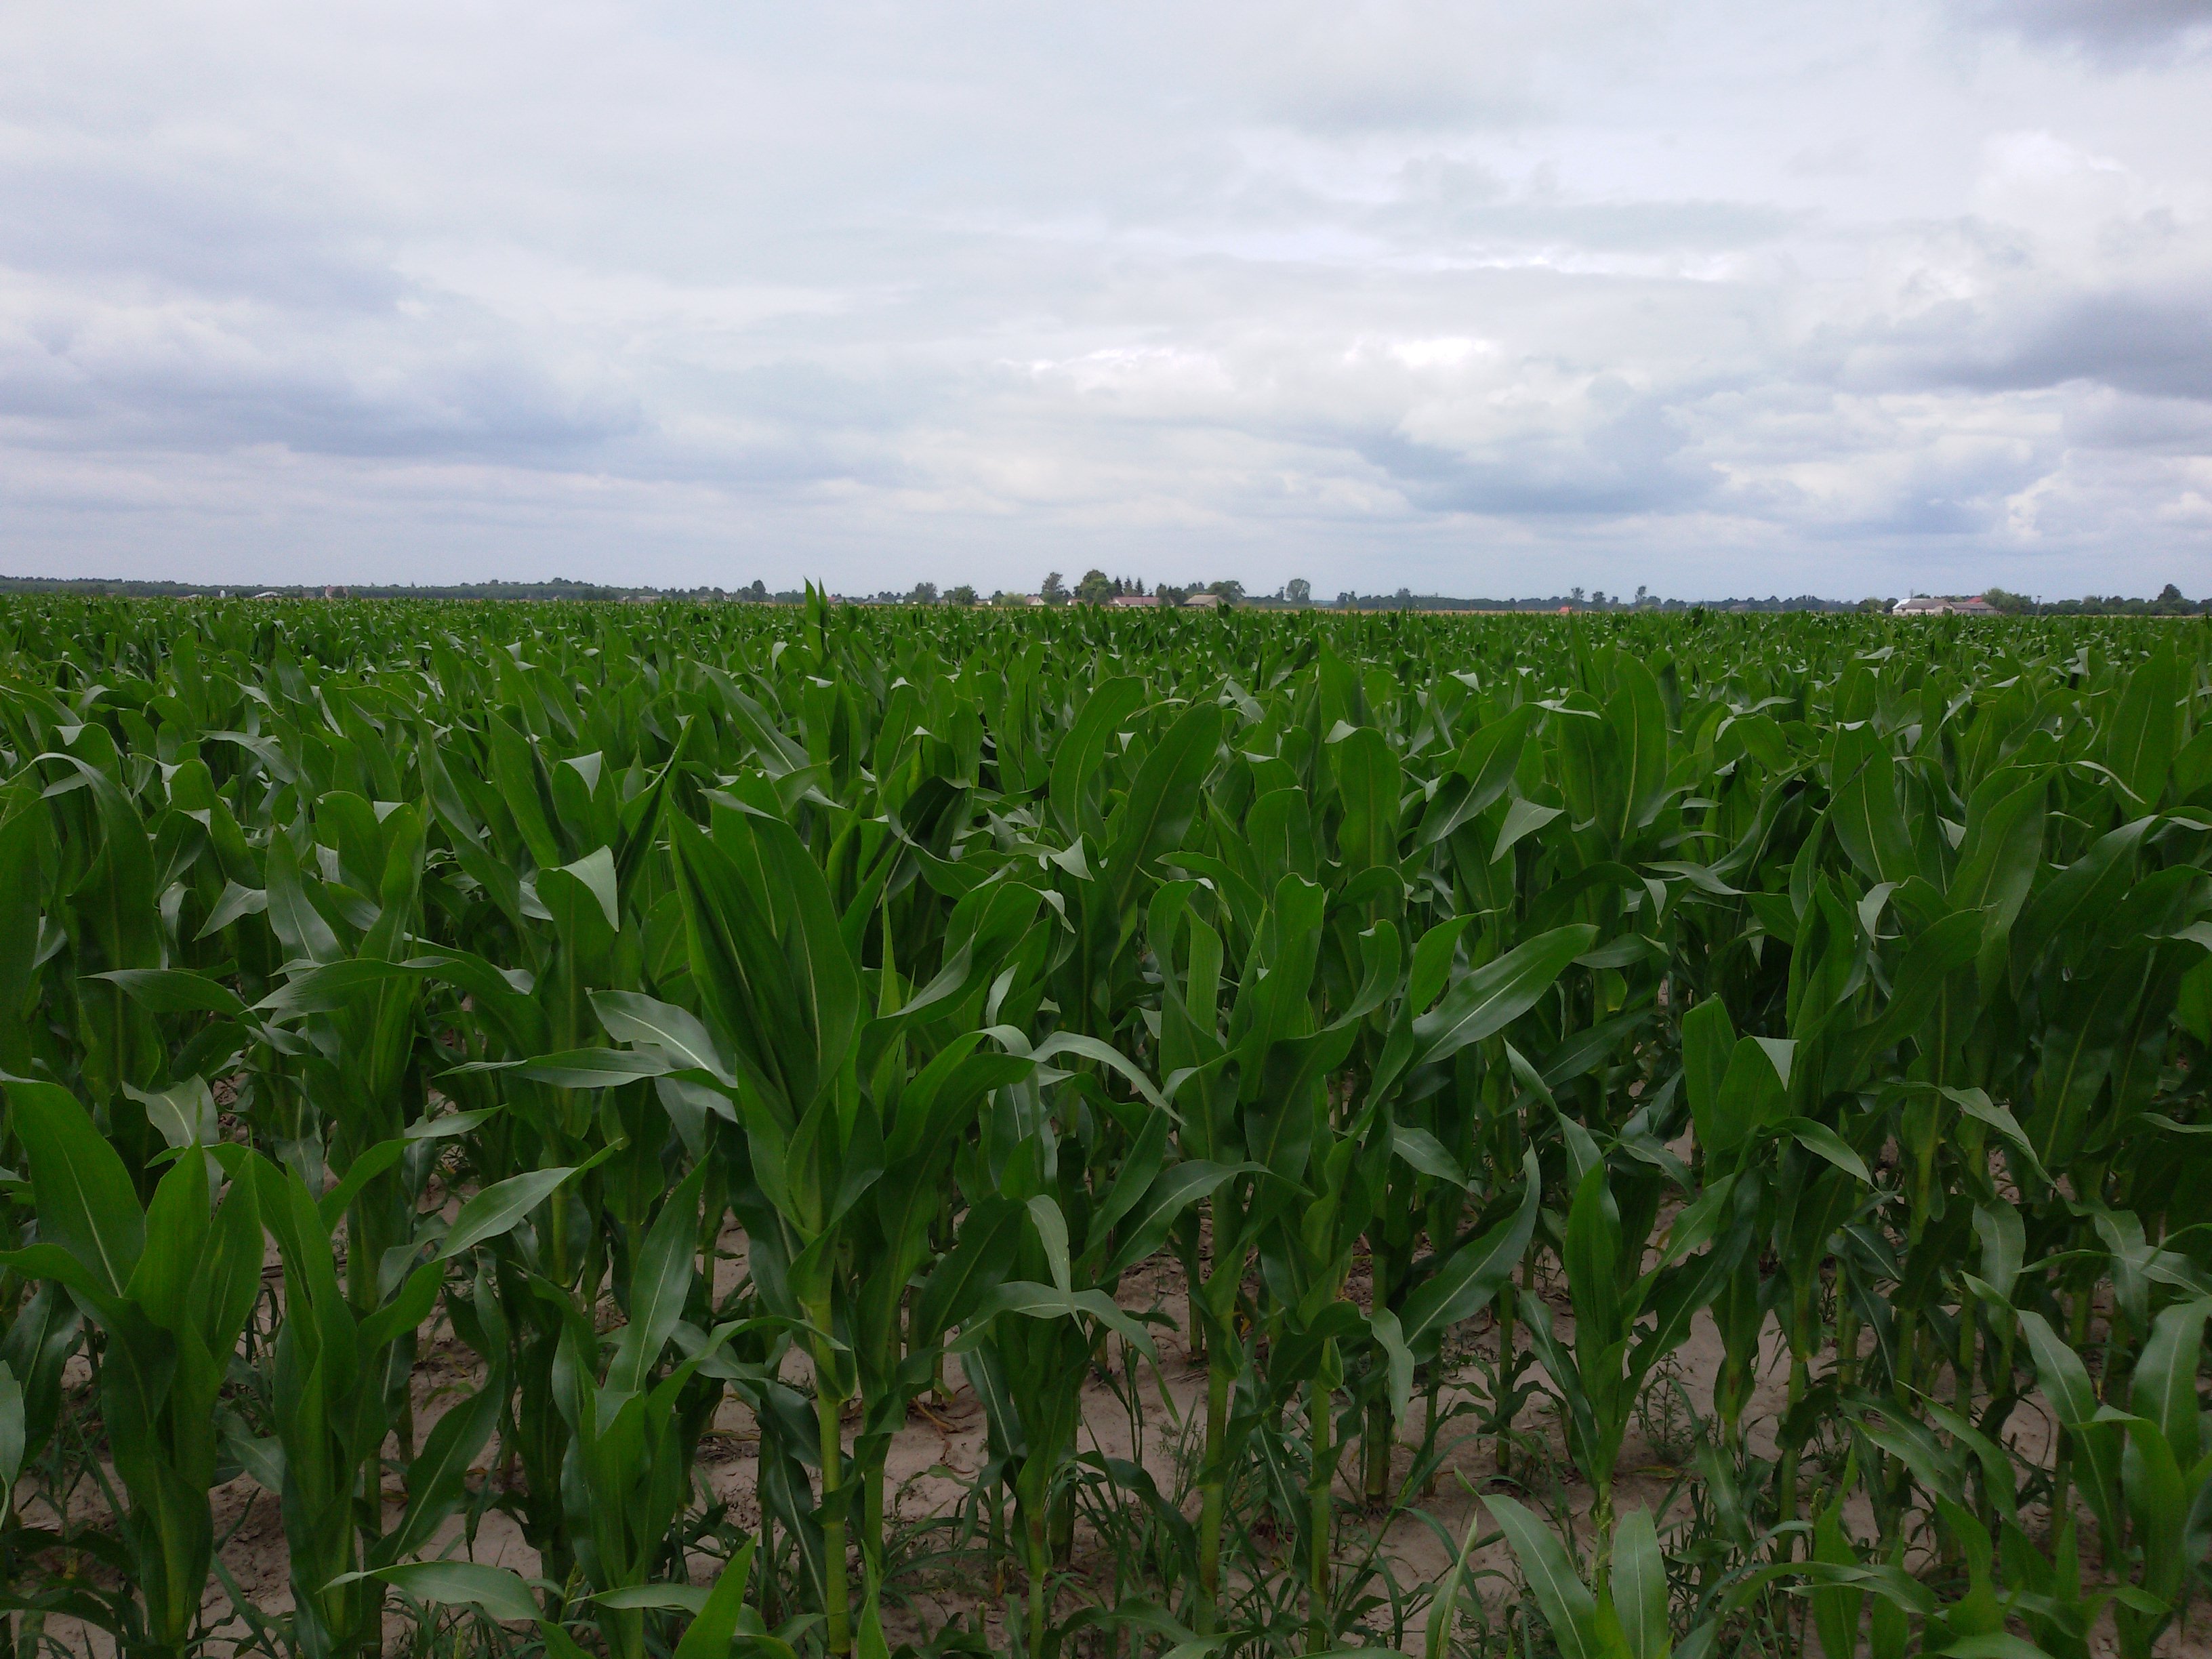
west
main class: Cropland
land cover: Maize
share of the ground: > 75 %
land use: Agriculture (excluding fallow land and kitchen gardens)
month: July
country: PL
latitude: 51.7998
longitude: 22.8774
